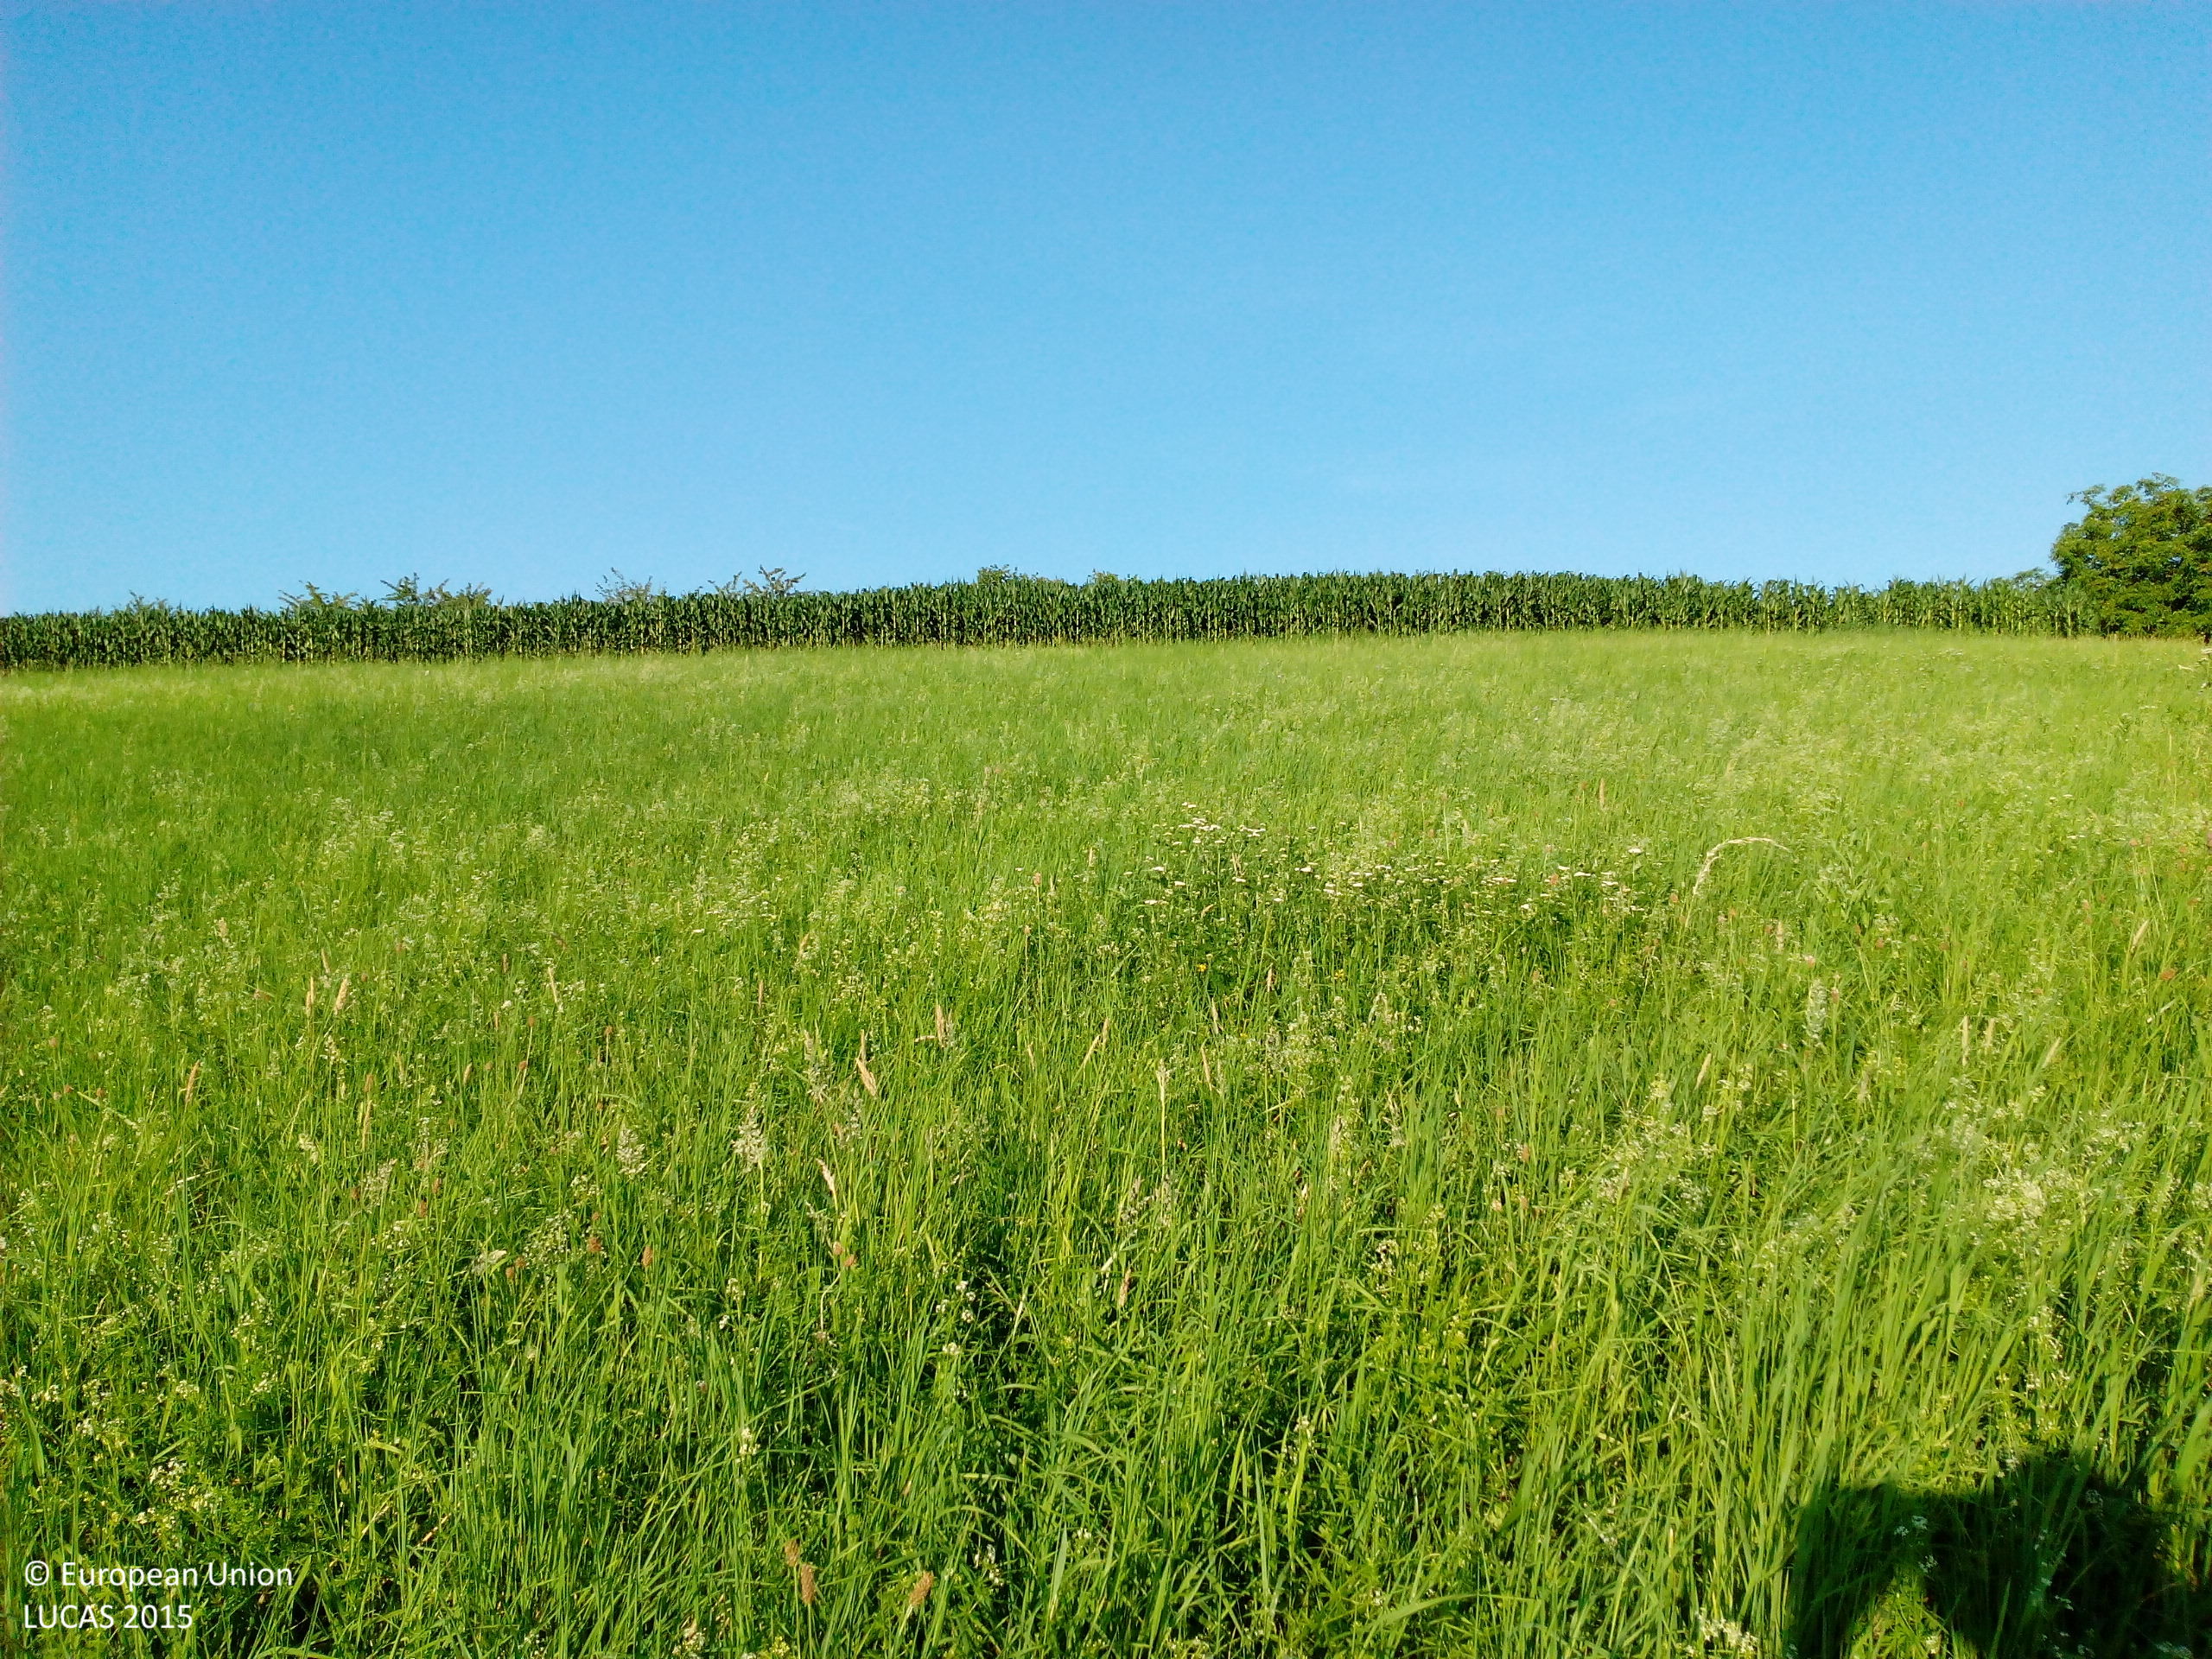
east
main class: Cropland
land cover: Other fruit trees and berries
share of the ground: < 10 %
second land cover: Grassland without tree/shrub cover
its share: > 75 %
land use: Agriculture (excluding fallow land and kitchen gardens)
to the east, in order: Other fruit trees and berries; Grassland without tree/shrub cover; Maize; Fences; Grassland without tree/shrub cover; Cherry fruit; Fences; Grass margins; Tracks; Maize
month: July
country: DE
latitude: 47.7116
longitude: 7.6156
